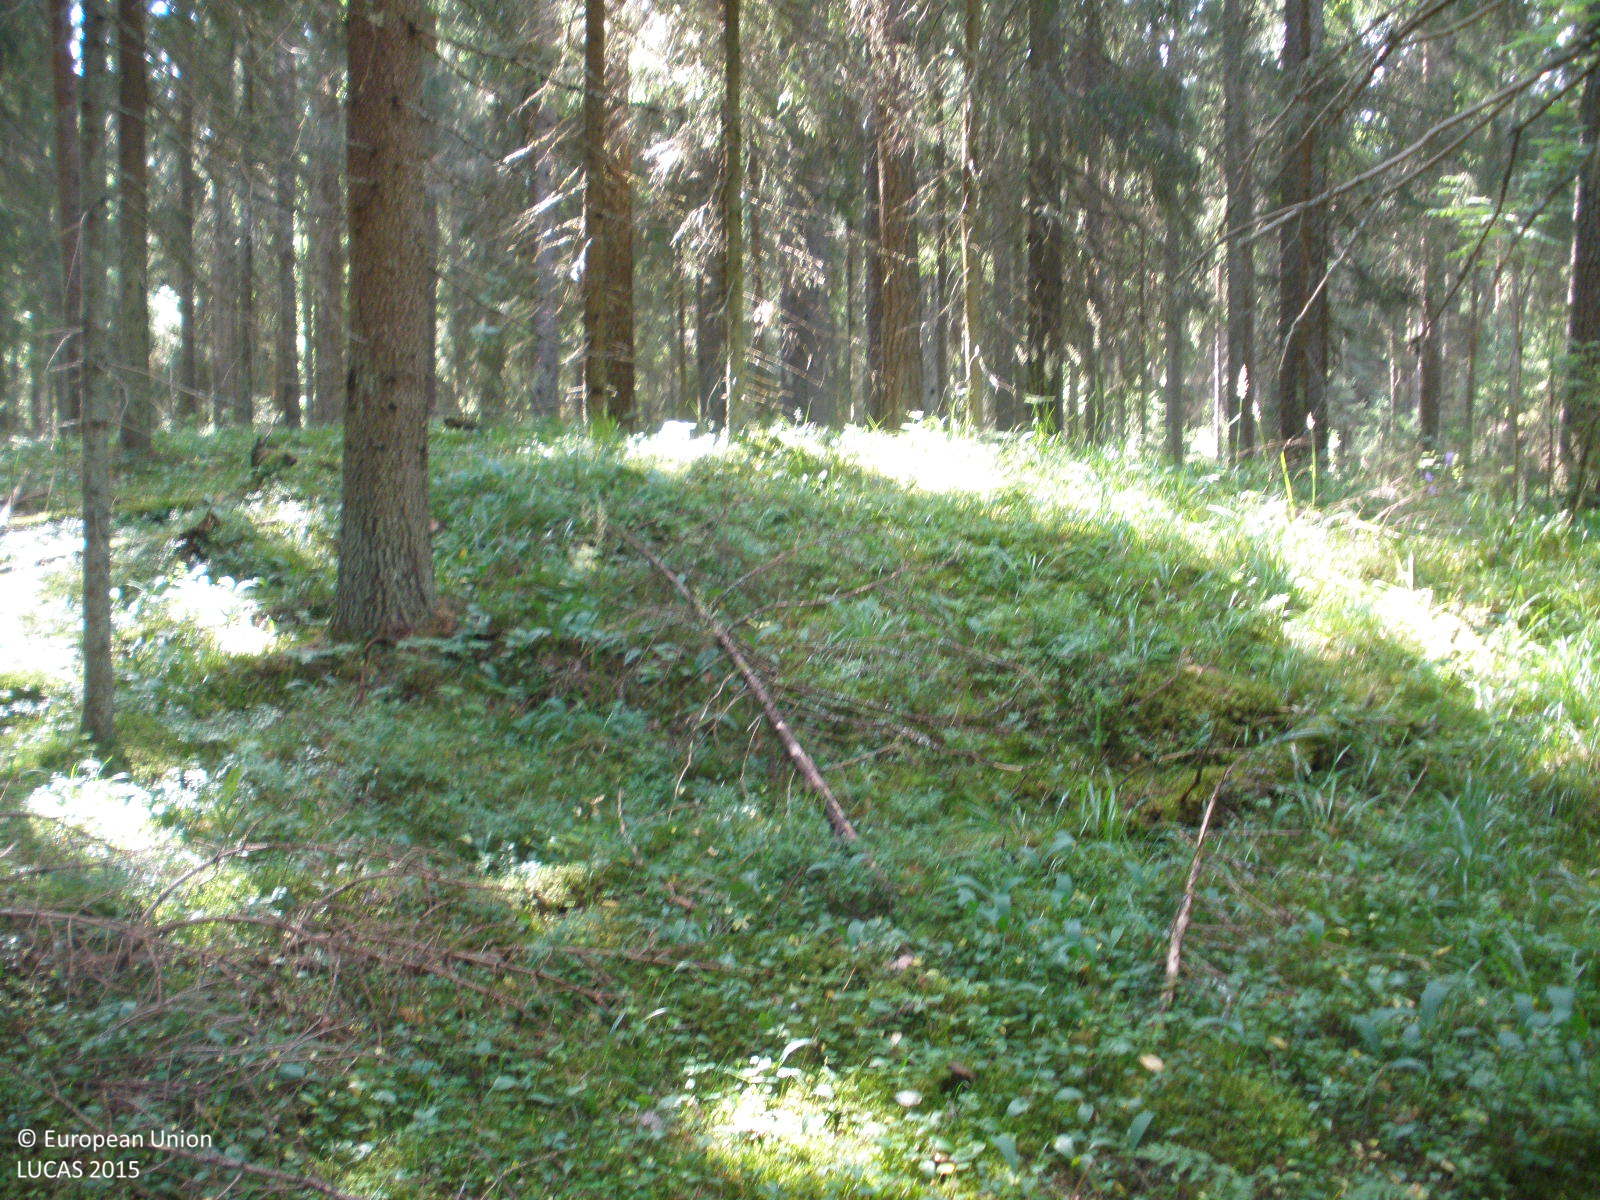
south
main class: Woodland
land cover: Spruce dominated coniferous woodland
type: boreal forest
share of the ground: > 75 %
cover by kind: coniferous forest trees 90 %, herbaceous plants 5 %, lichens and mosses 5 %
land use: Forestry
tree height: > 5 m
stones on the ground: < 10 %
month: August
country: FI
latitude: 60.9802
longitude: 24.9137
